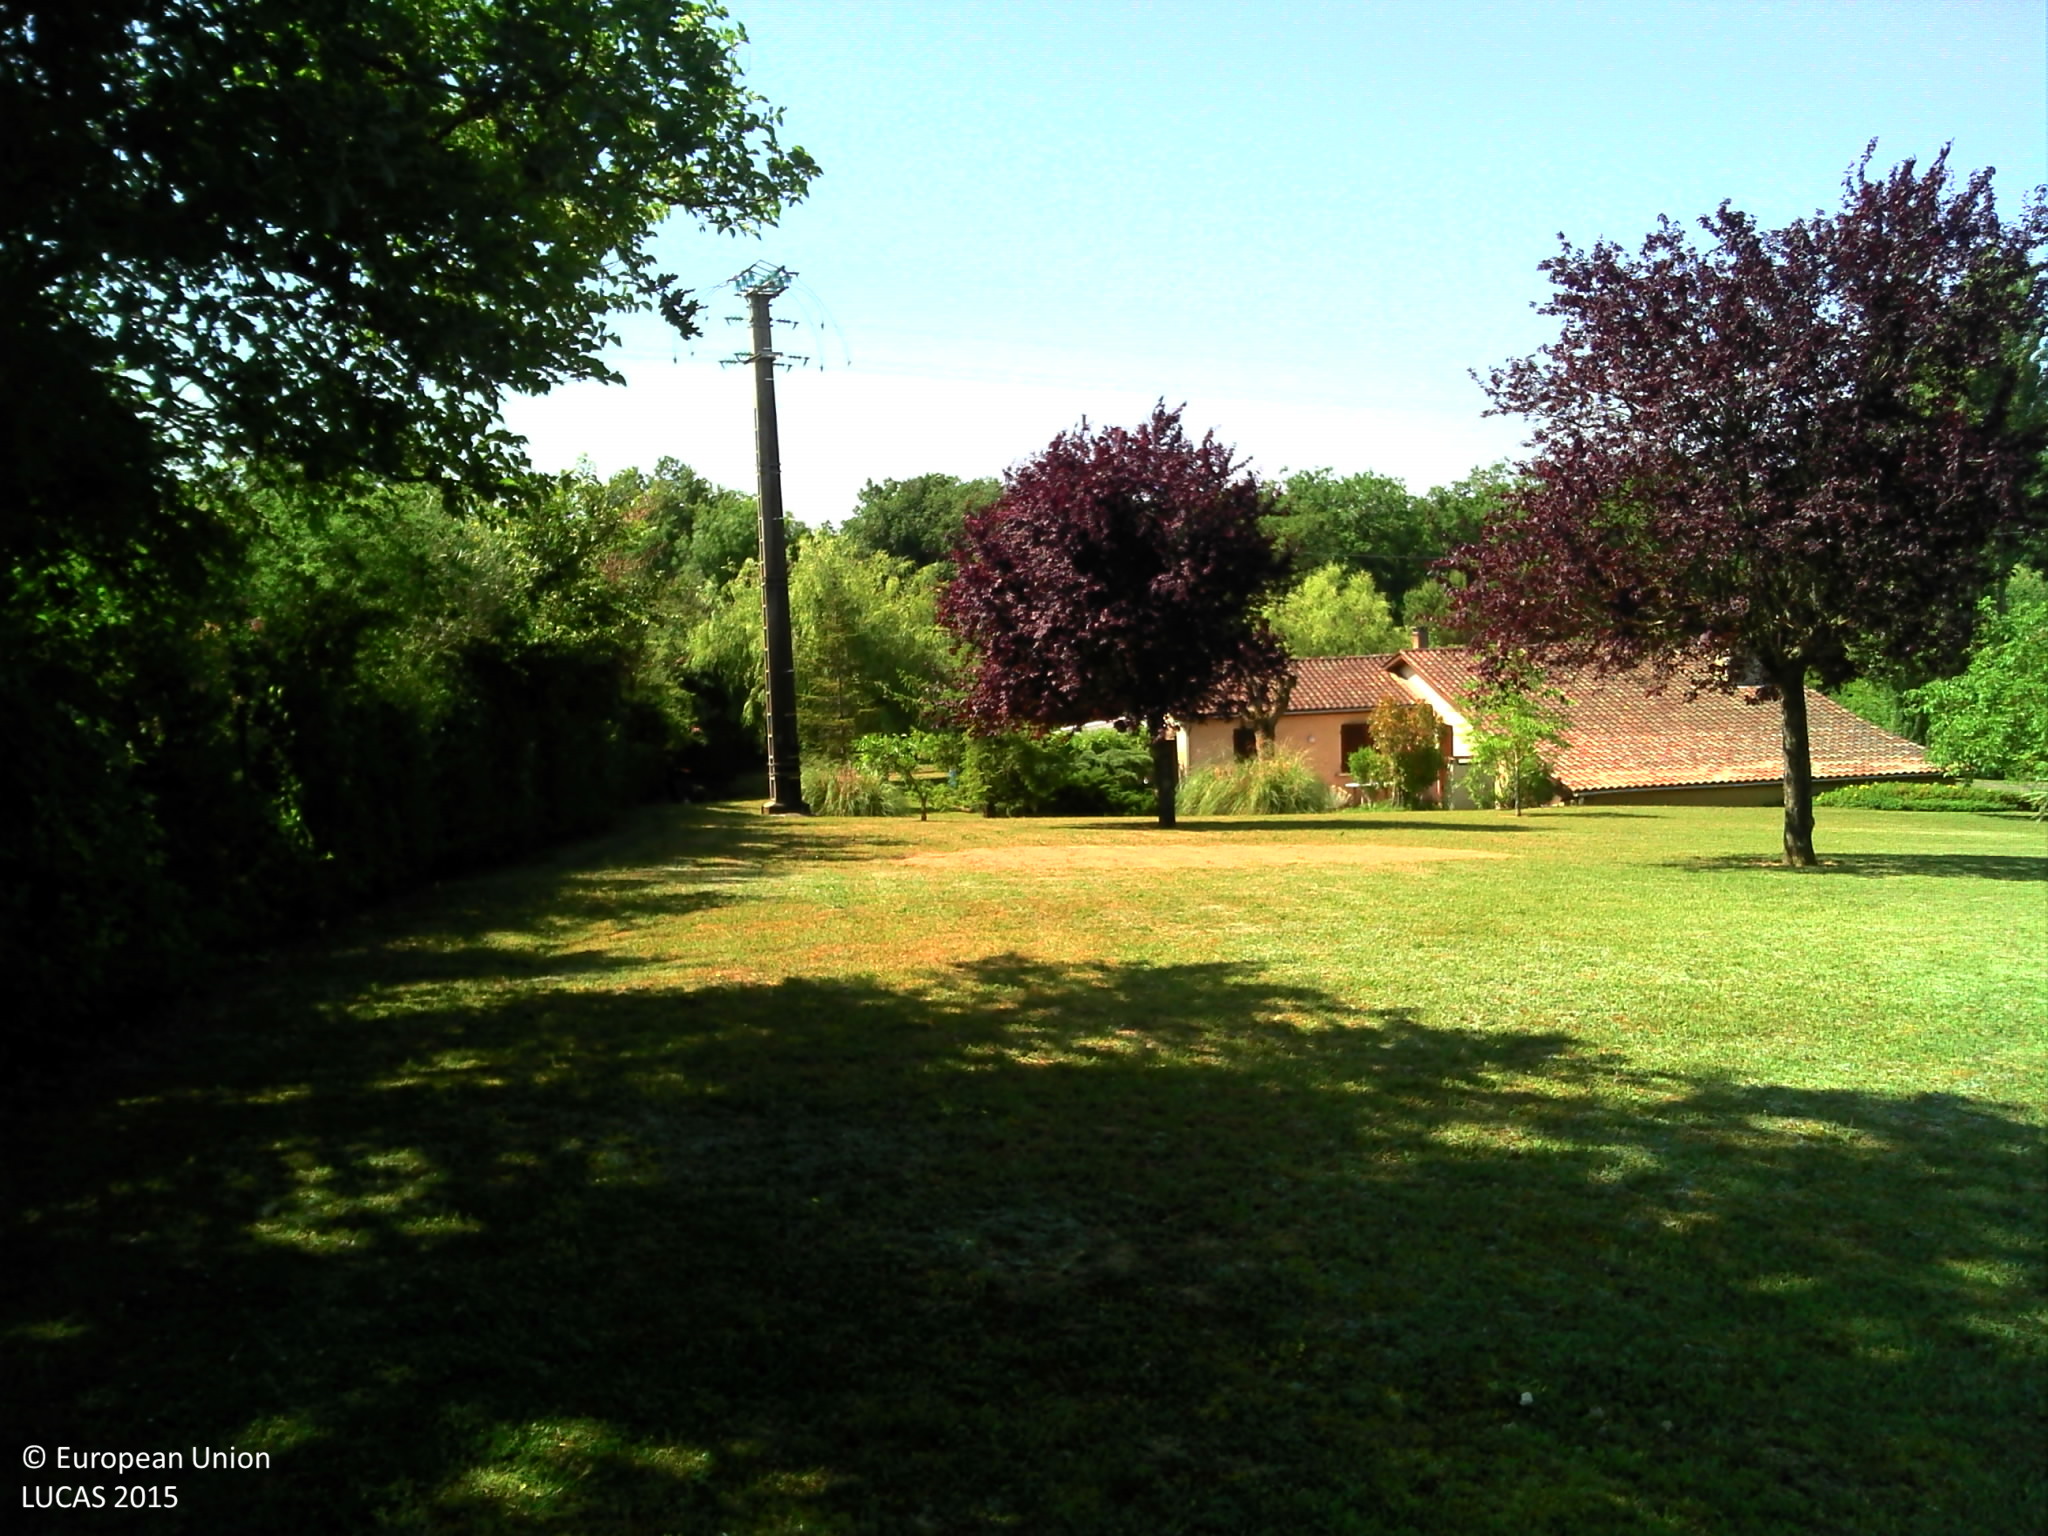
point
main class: Grassland
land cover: Grassland with sparse tree/shrub cover
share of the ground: > 75 %
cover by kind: herbaceous plants 95 %, broadleaved forest trees 5 %
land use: Residential
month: June
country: FR
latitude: 43.6586
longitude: 0.6858
